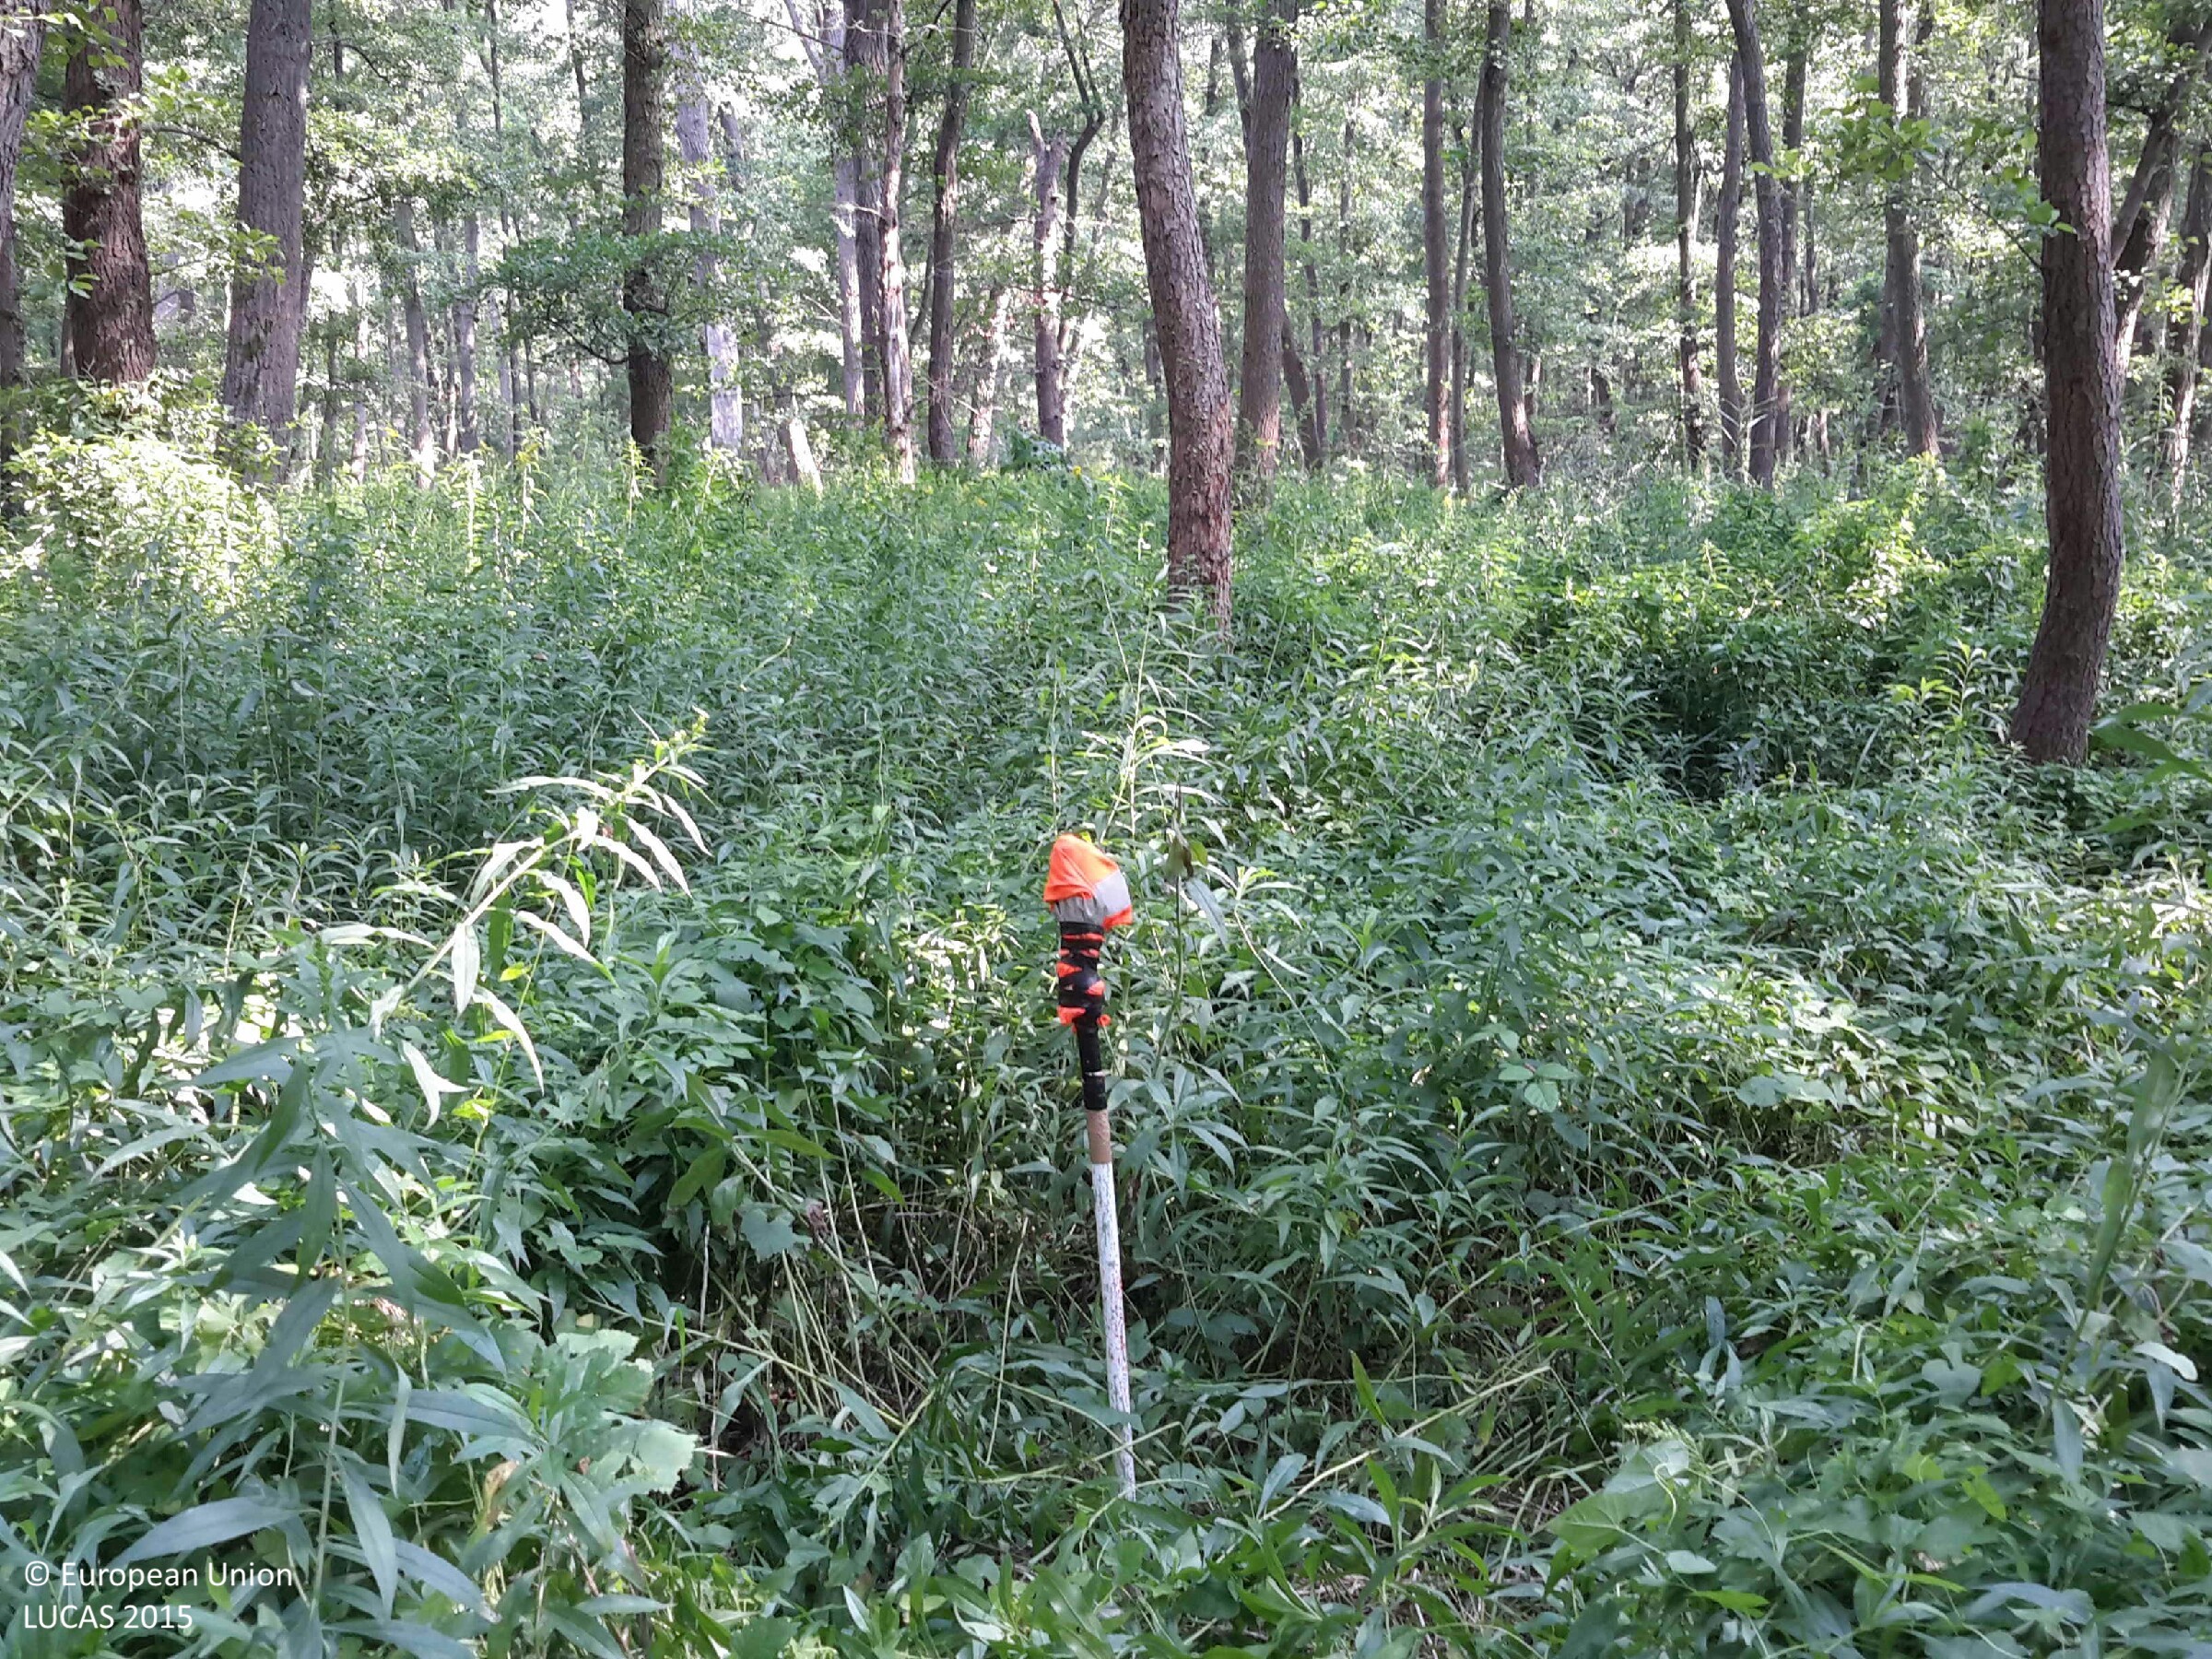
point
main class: Woodland
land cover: Broadleaved woodland
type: mesophytic deciduous forest
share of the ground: > 75 %
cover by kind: broadleaved forest trees 90 %, herbaceous plants 10 %
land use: Forestry
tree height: > 5 m
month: August
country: HU
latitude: 47.7463
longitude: 17.3034
